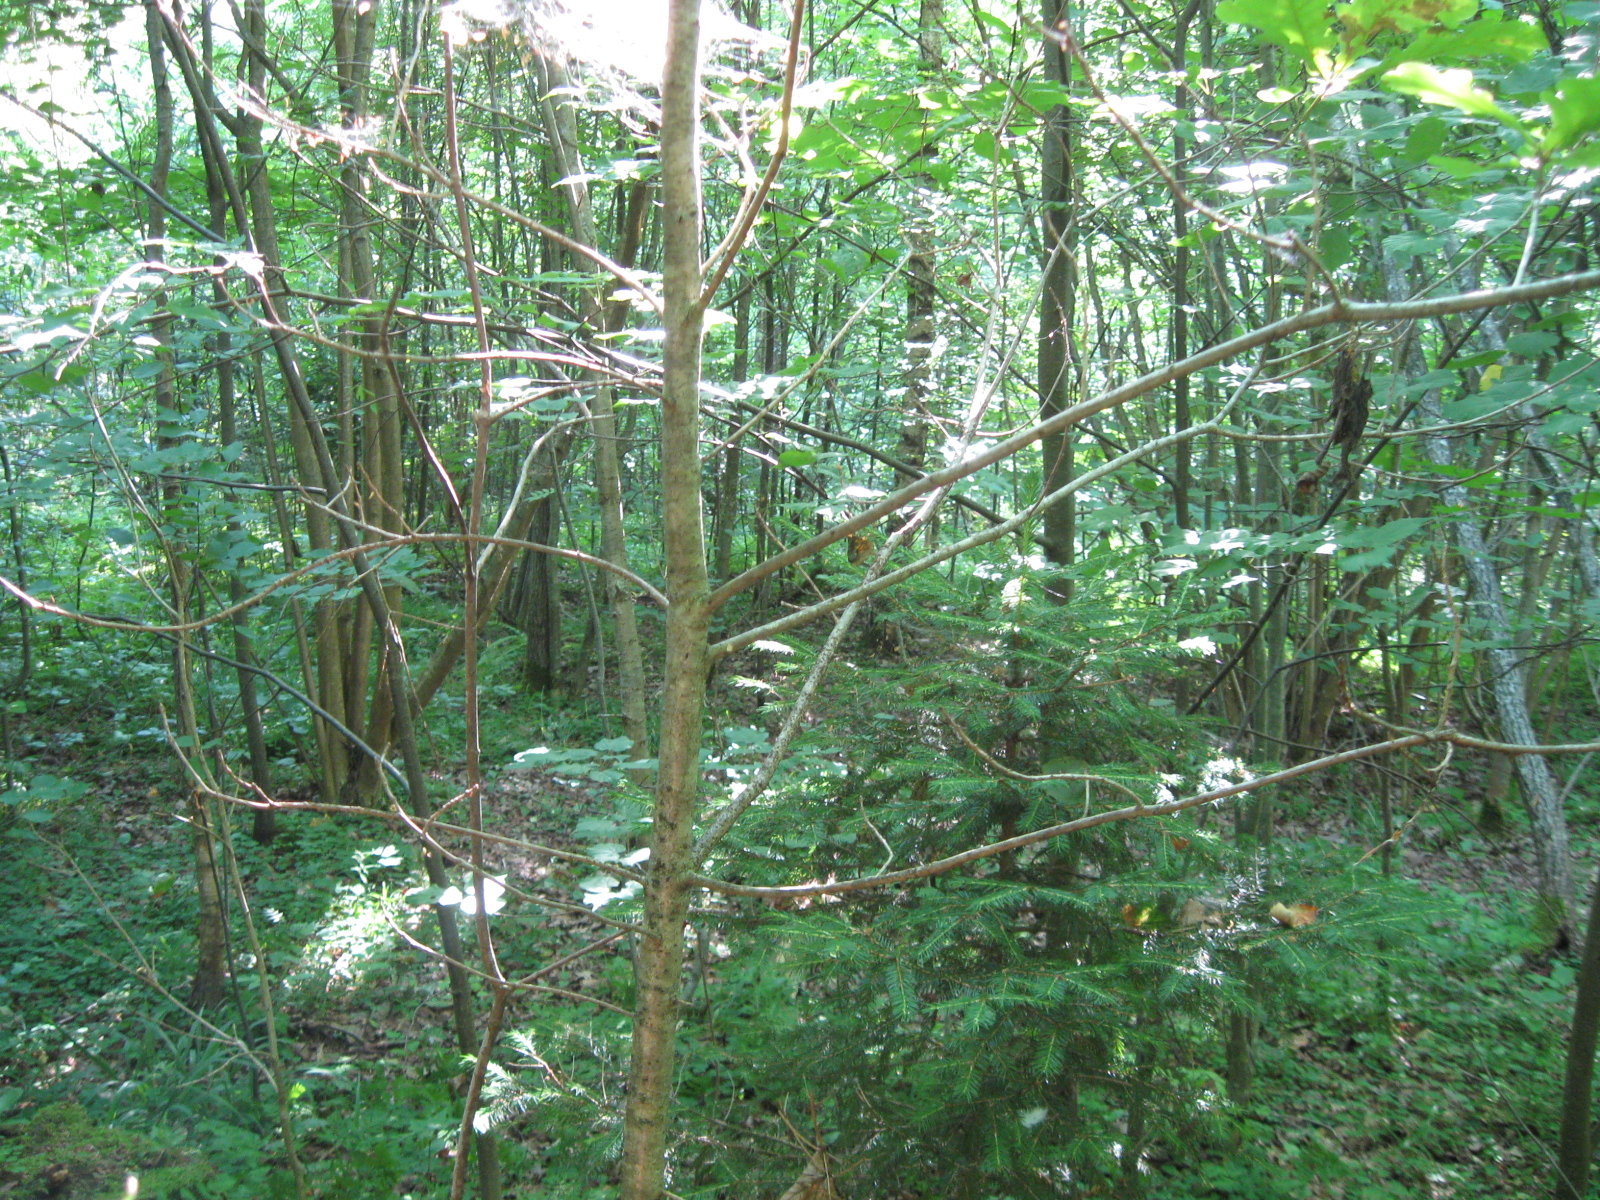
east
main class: Woodland
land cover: Broadleaved woodland
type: non-riverine alder, birch or aspen forest
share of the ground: > 75 %
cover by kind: broadleaved forest trees 90 %, herbaceous plants 10 %
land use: Forestry
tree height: > 5 m
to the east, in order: Broadleaved woodland; Tracks; Broadleaved woodland; Spruce dominated mixed woodland; Ditches and canals; Broadleaved woodland; Common wheat
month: July
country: LT
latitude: 54.7744
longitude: 23.8462
